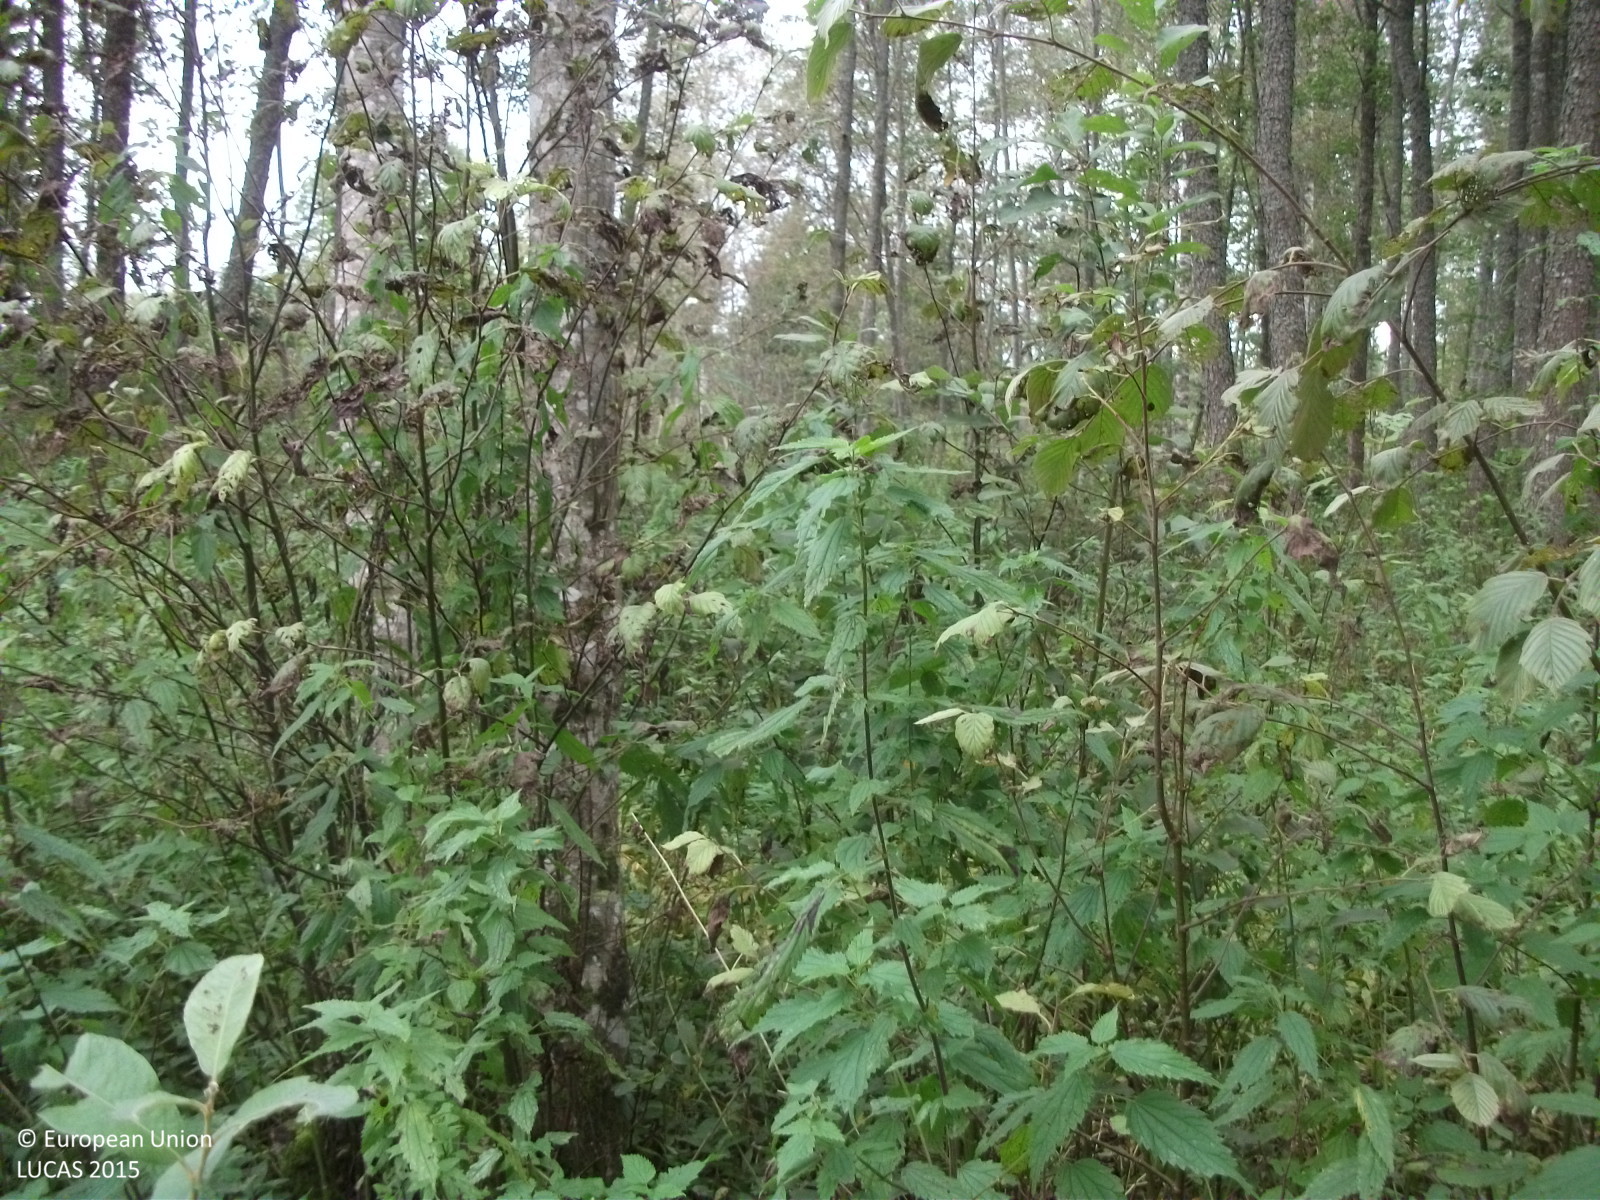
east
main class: Woodland
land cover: Broadleaved woodland
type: non-riverine alder, birch or aspen forest
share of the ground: 50 - 75 %
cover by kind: broadleaved forest trees 70 %, herbaceous plants 20 %, shrubs 10 %
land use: Forestry
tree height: > 5 m
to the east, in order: Broadleaved woodland
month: September
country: LV
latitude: 57.7498
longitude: 24.7295
